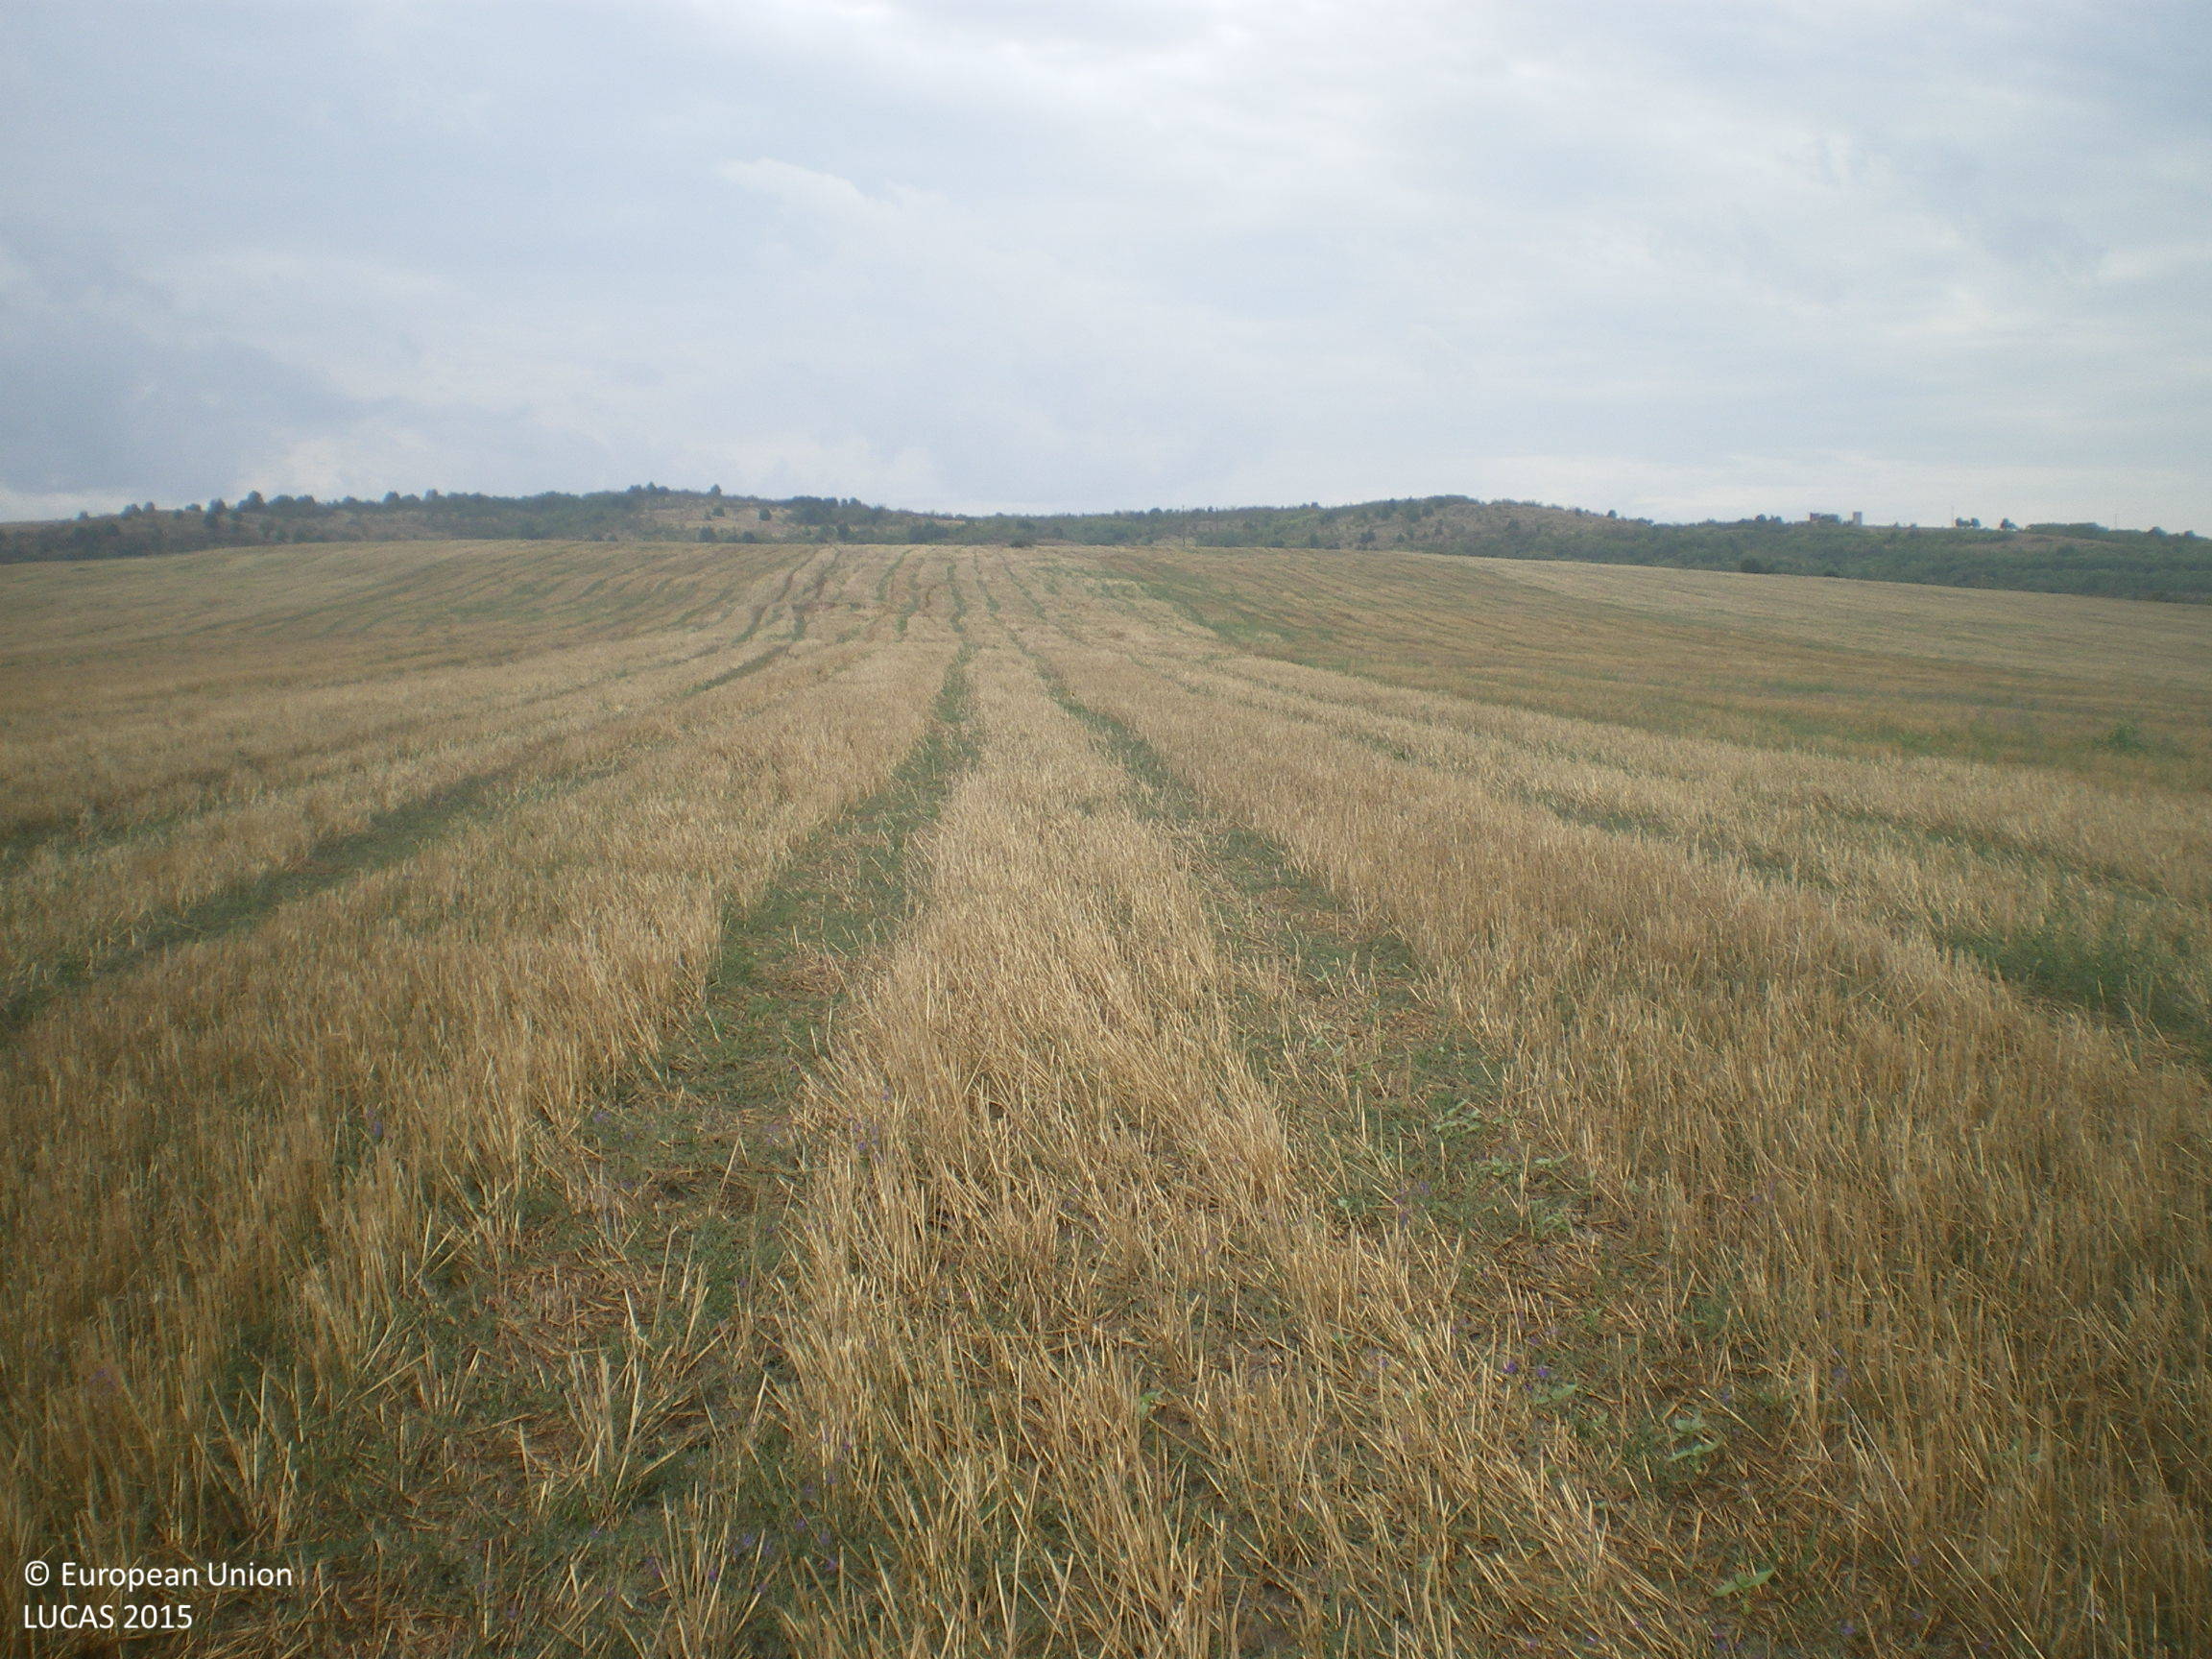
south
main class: Cropland
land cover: Common wheat
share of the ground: 25 - 50 %
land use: Agriculture (excluding fallow land and kitchen gardens)
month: September
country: BG
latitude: 41.9499
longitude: 25.8371
